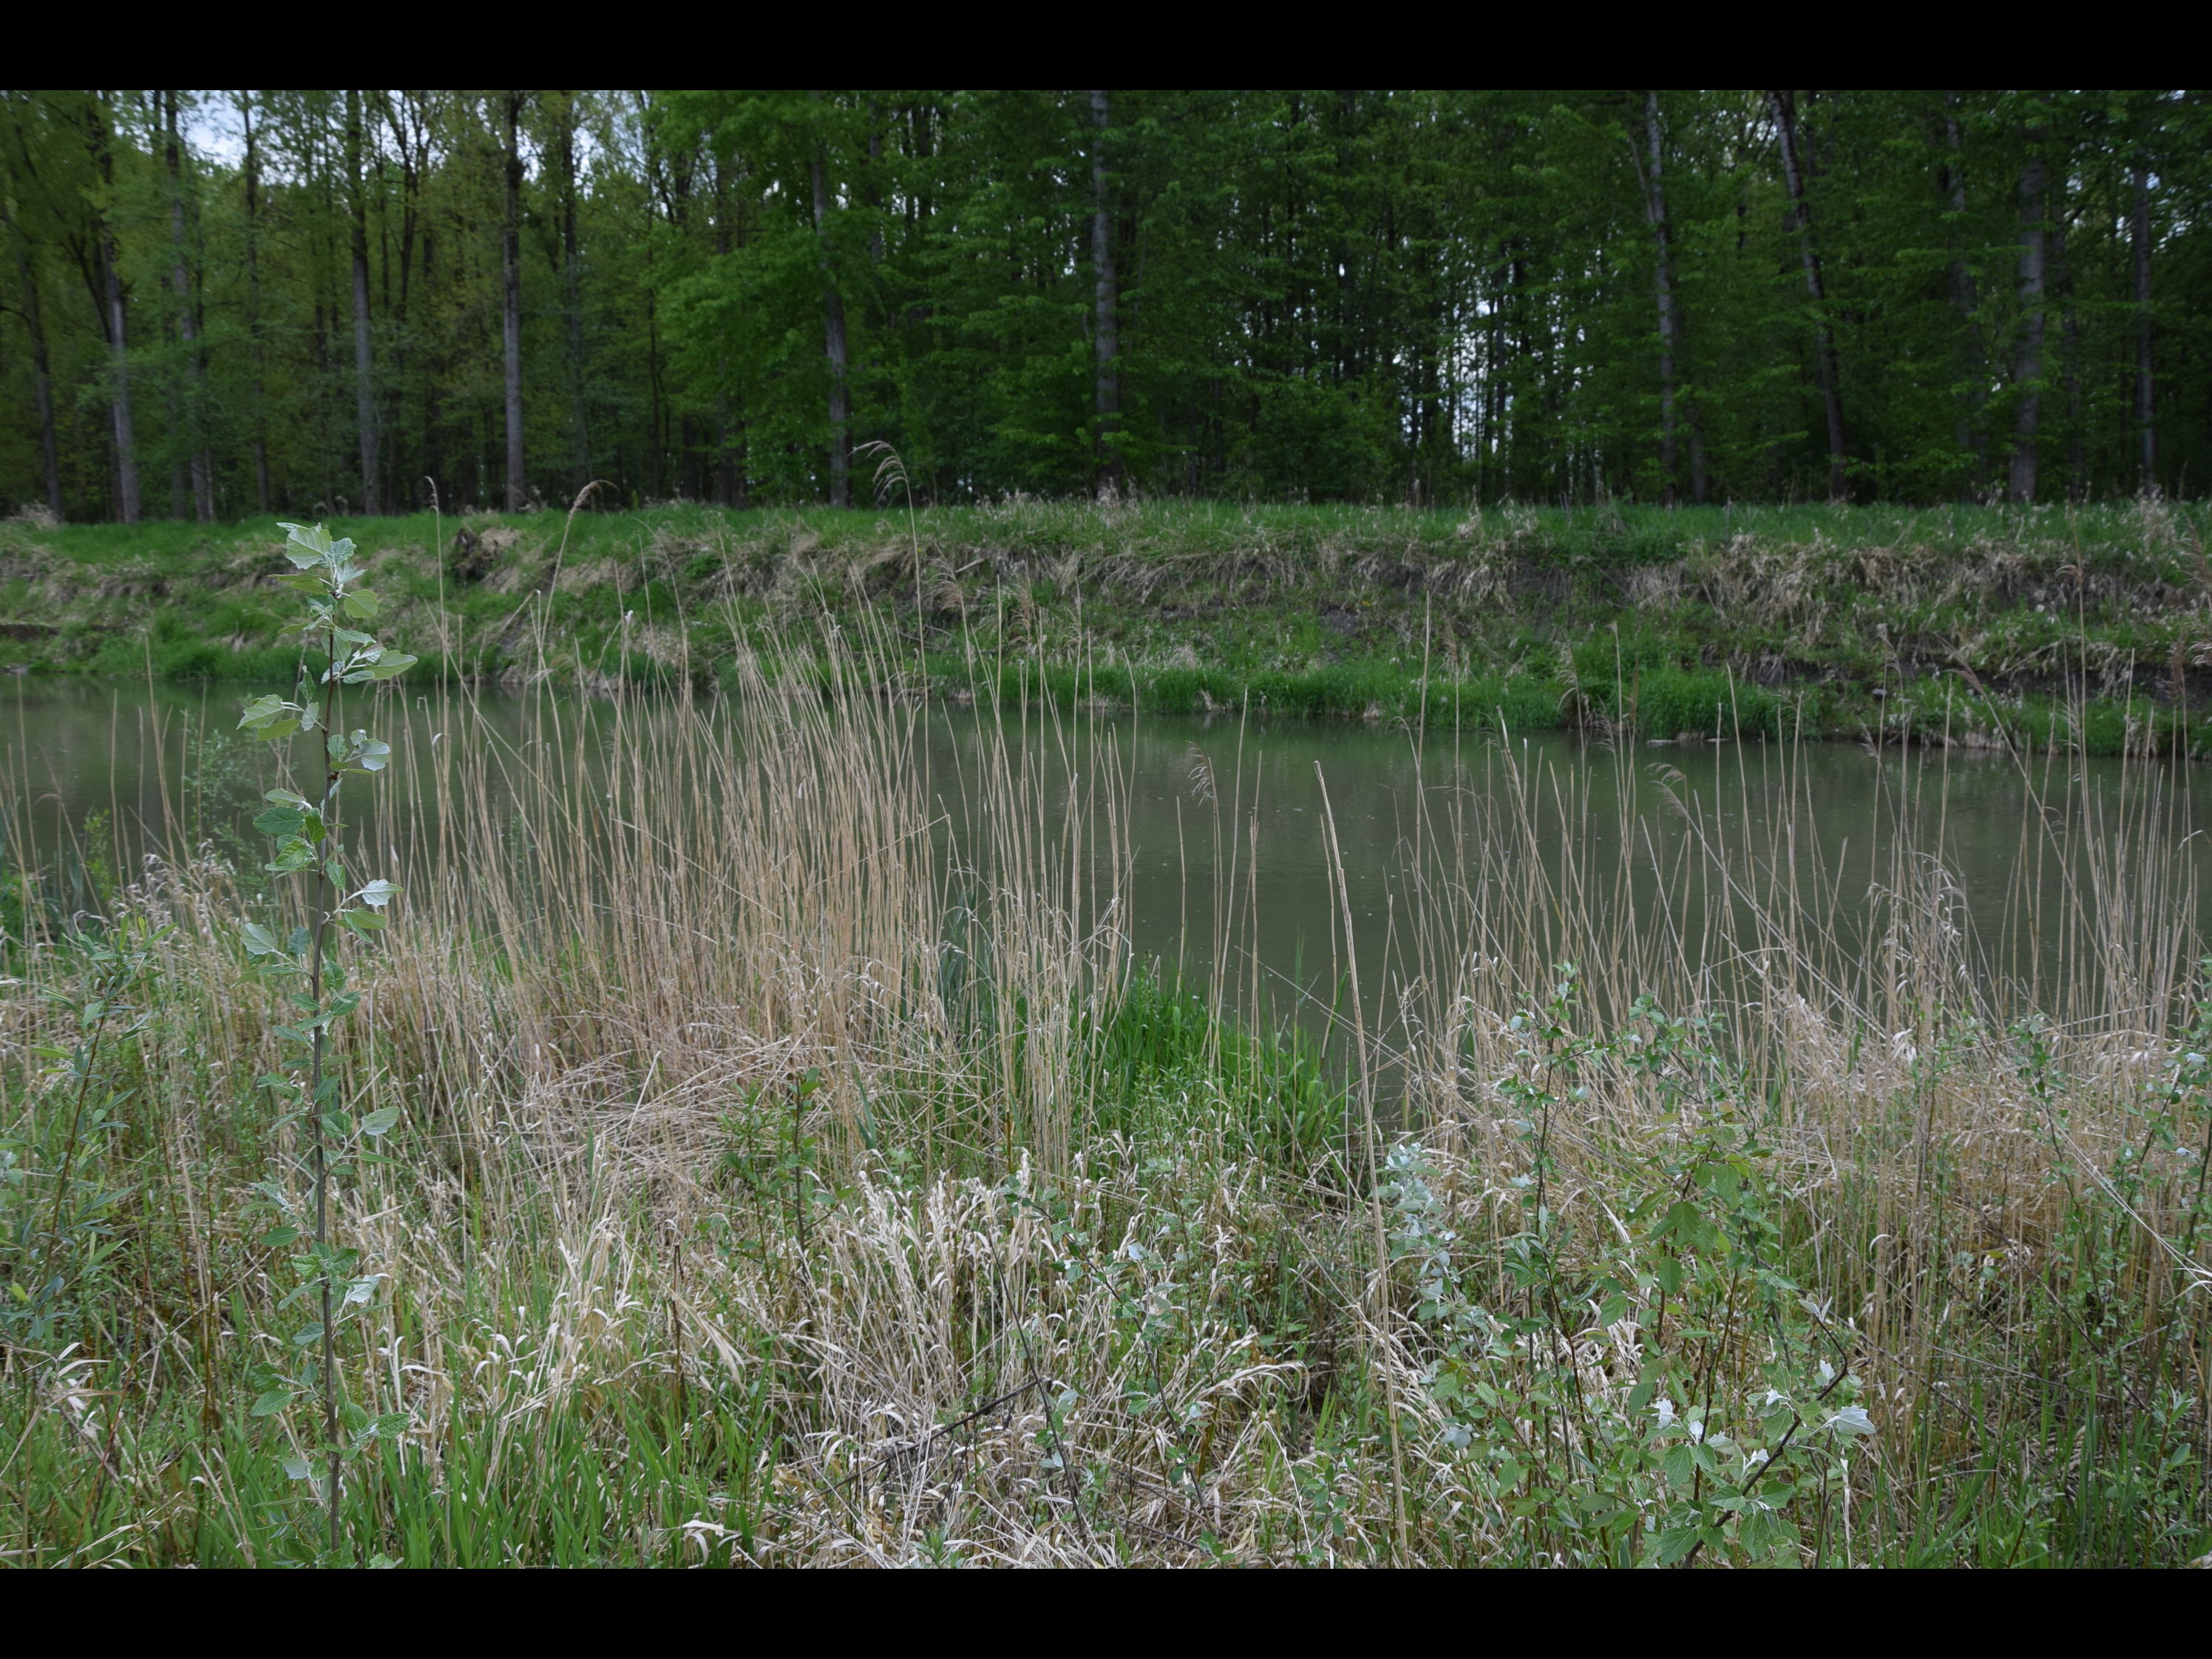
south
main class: Shrubland
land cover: Shrubland with sparse tree cover
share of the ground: > 75 %
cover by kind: herbaceous plants 80 %, shrubs 15 %, broadleaved forest trees 5 %
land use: Semi-natural and natural areas not in use
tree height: < 5 m
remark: Temporary flooded
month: May
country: AT
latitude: 48.1990
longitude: 14.6153
